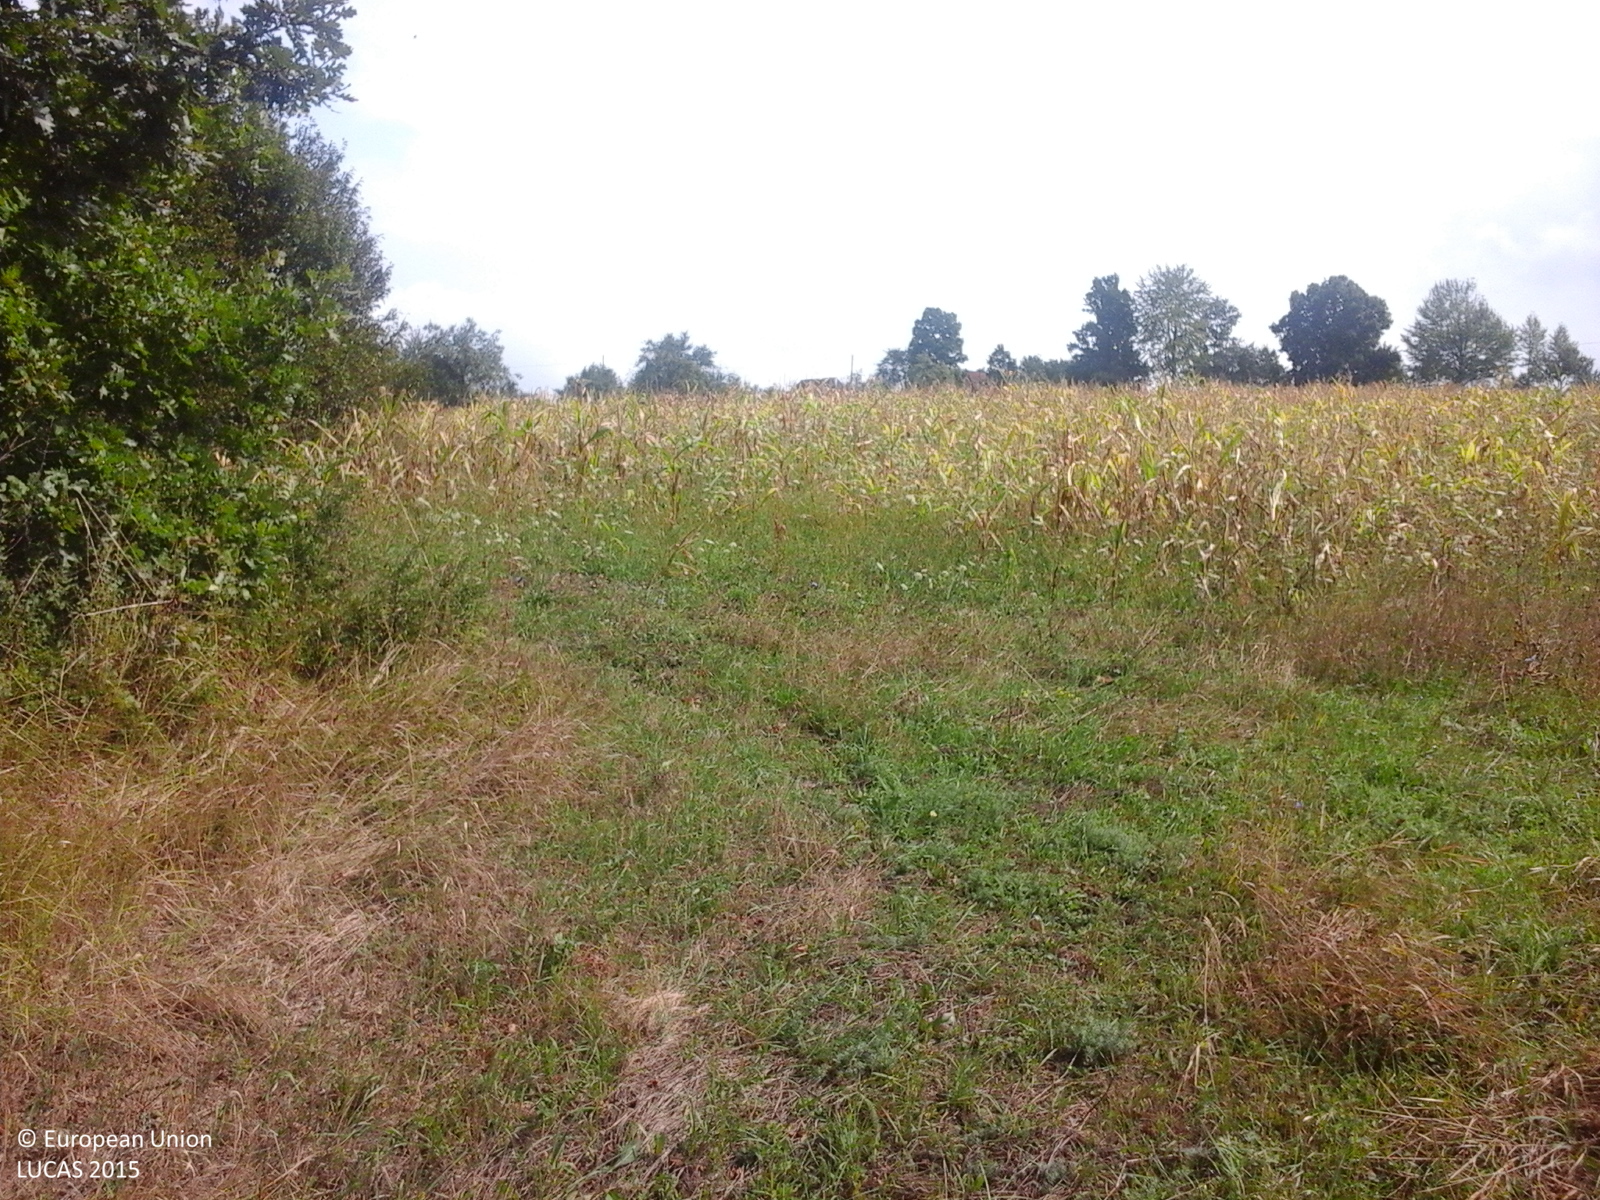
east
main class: Grassland
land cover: Grassland without tree/shrub cover
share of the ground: > 75 %
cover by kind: herbaceous plants 100 %
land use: Agriculture (excluding fallow land and kitchen gardens)
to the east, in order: Grassland without tree/shrub cover; Maize; Other bare soil; Lines of trees; Other bare soil; Common wheat; Lines of trees; Common wheat; Grassland without tree/shrub cover; Shruby margins; Grassland without tree/shrub cover; Other fruit trees and berries; Other leguminous and mixtures for fodder; Grassland without tree/shrub cover; Other fruit trees and berries
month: September
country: RO
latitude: 46.9565
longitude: 22.5514
